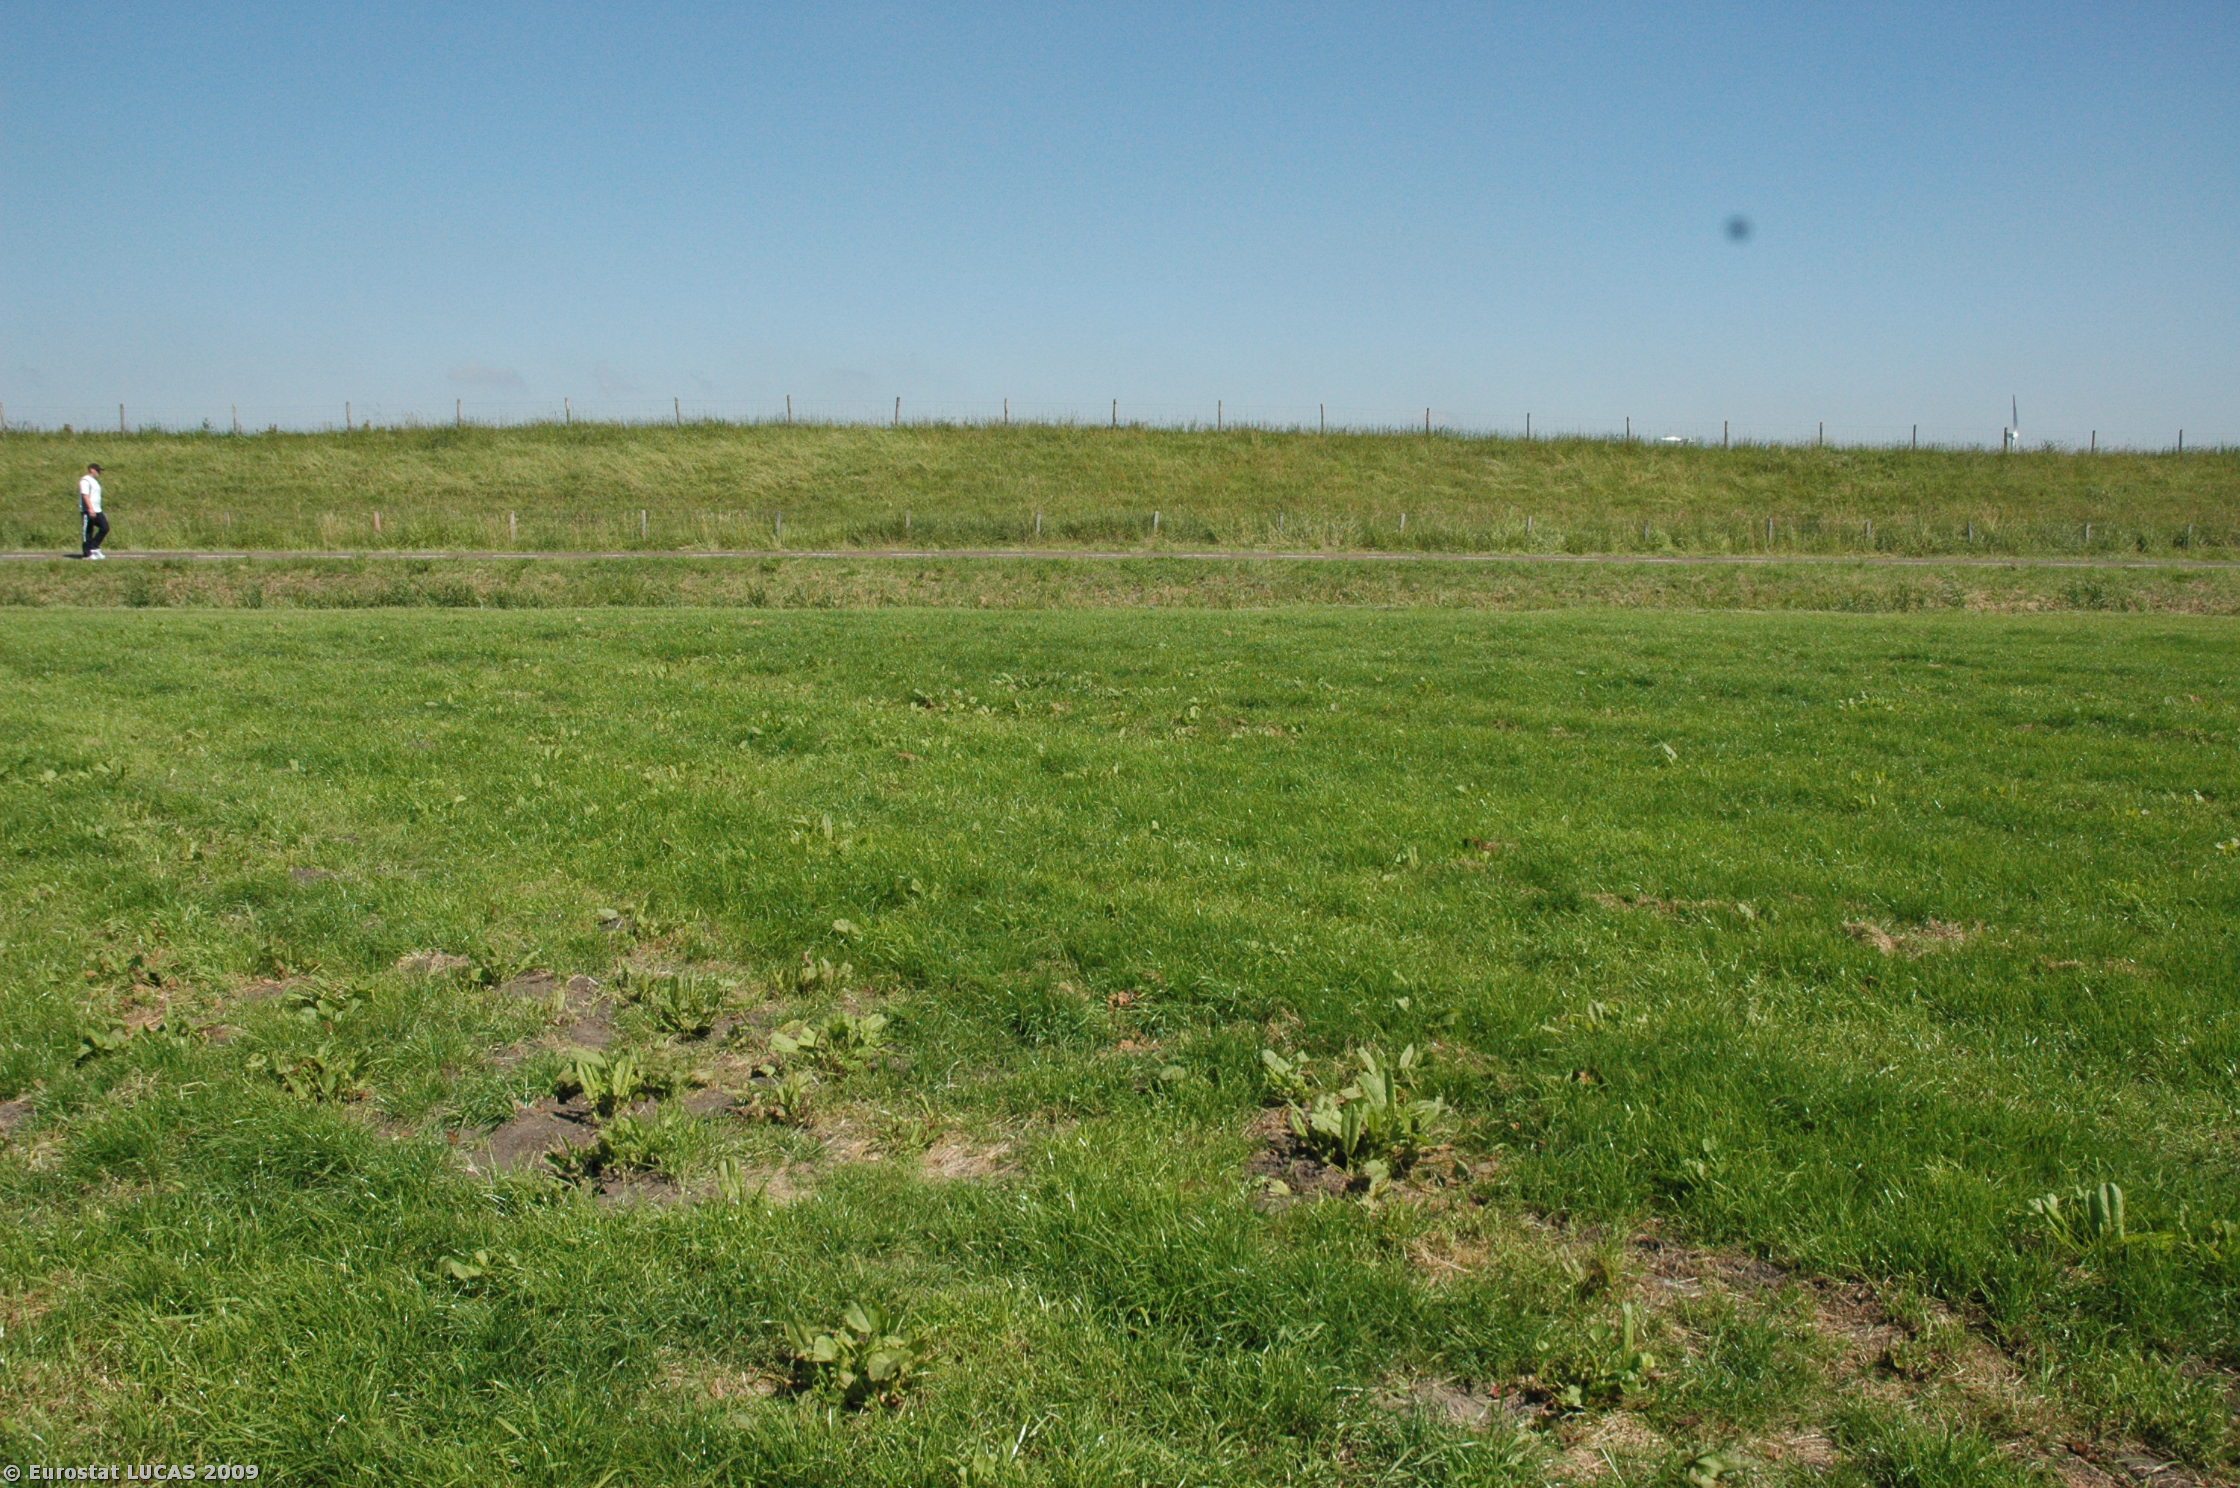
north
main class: Grassland
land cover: Grassland without tree/shrub cover
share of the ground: > 75 %
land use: Agriculture (excluding fallow land and kitchen gardens)
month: June
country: NL
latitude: 52.2685
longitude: 5.3528
